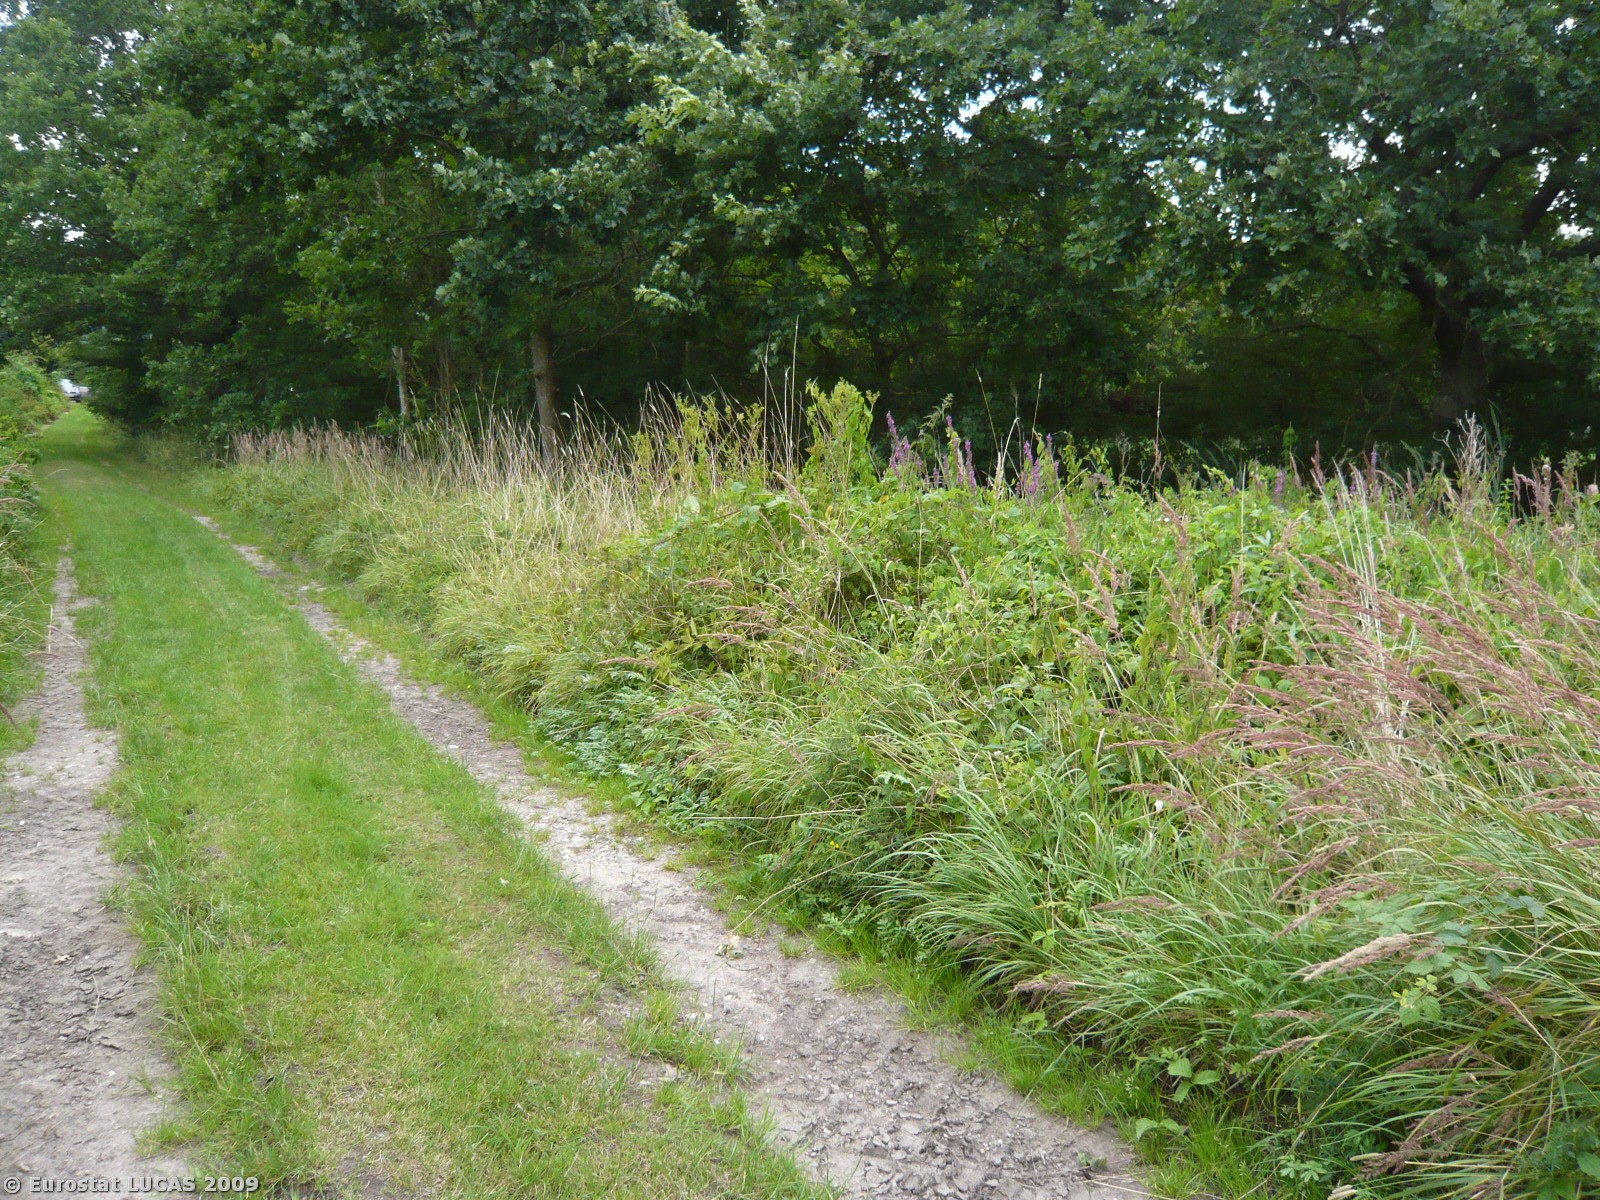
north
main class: Woodland
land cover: Broadleaved woodland
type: mesophytic deciduous forest
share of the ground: > 75 %
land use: Amenities, museums, leisure
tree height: > 5 m
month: August
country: DK
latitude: 55.9574
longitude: 11.9362
